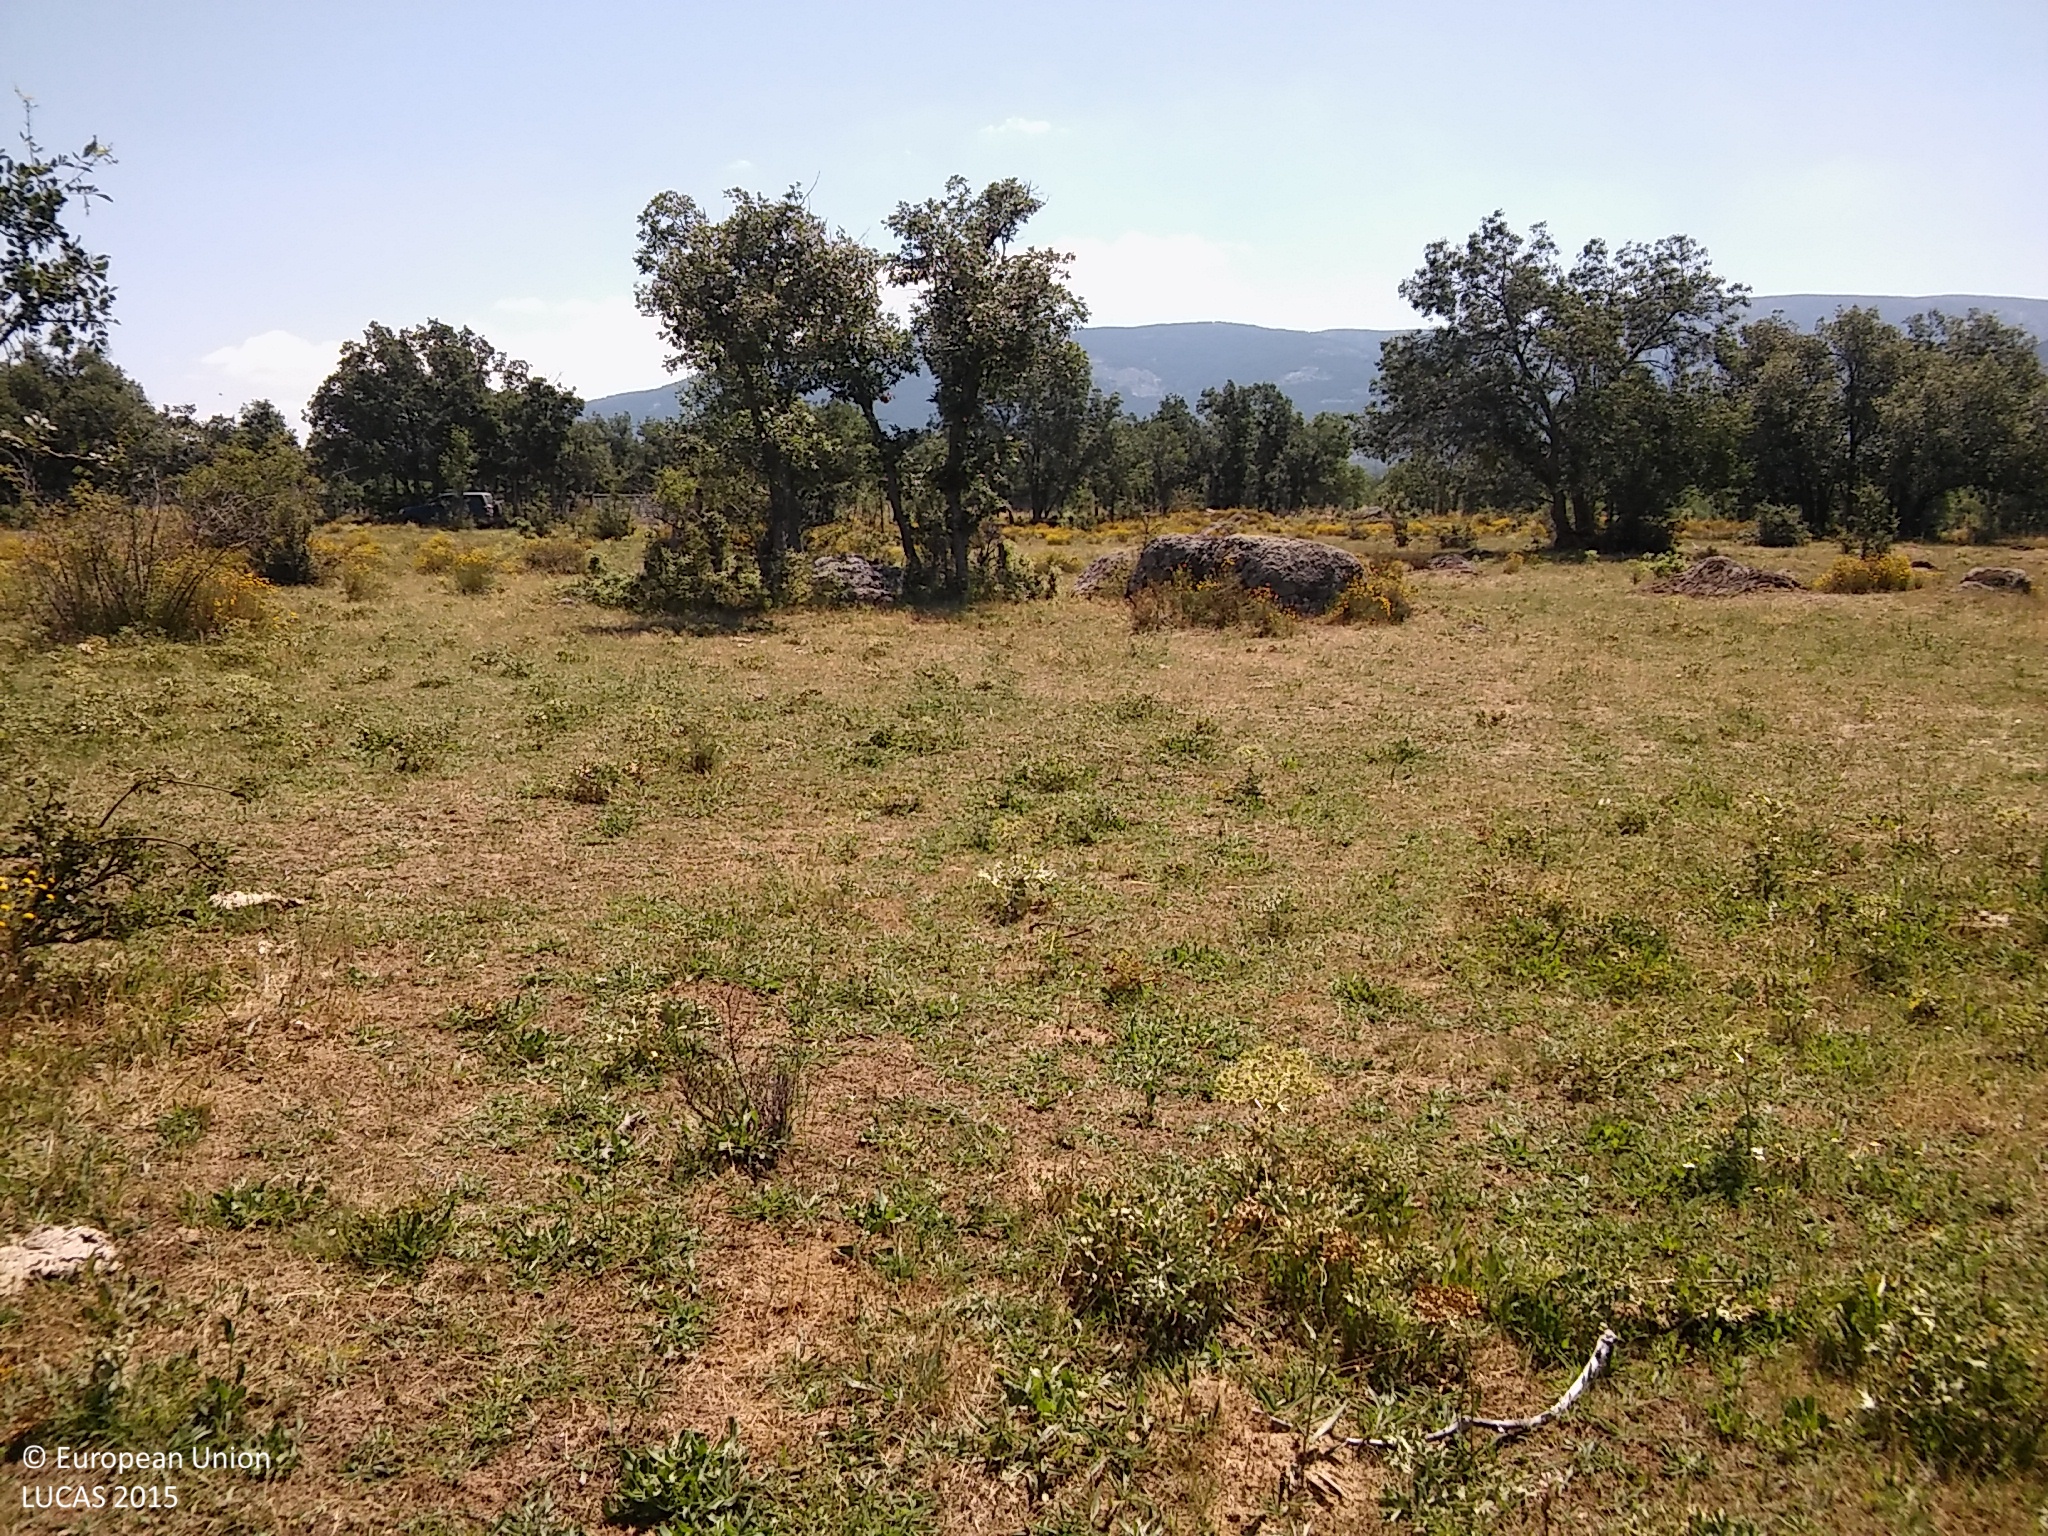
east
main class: Woodland
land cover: Broadleaved woodland
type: broadleaved evergreen forest
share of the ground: 10 - 25 %
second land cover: Grassland without tree/shrub cover
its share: 50 - 75 %
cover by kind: herbaceous plants 75 %, broadleaved forest trees 15 %, shrubs 10 %
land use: Forestry
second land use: Agriculture (excluding fallow land and kitchen gardens)
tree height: > 5 m
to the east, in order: Broadleaved woodland; Grassland without tree/shrub cover; Tracks; Broadleaved woodland; Tracks; Fences; Grassland with sparse tree/shrub cover; Fences; Grass margins; Tracks; Grass margins; Dry stone walls; Grassland with sparse tree/shrub cover
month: June
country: ES
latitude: 41.0418
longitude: -3.9555
